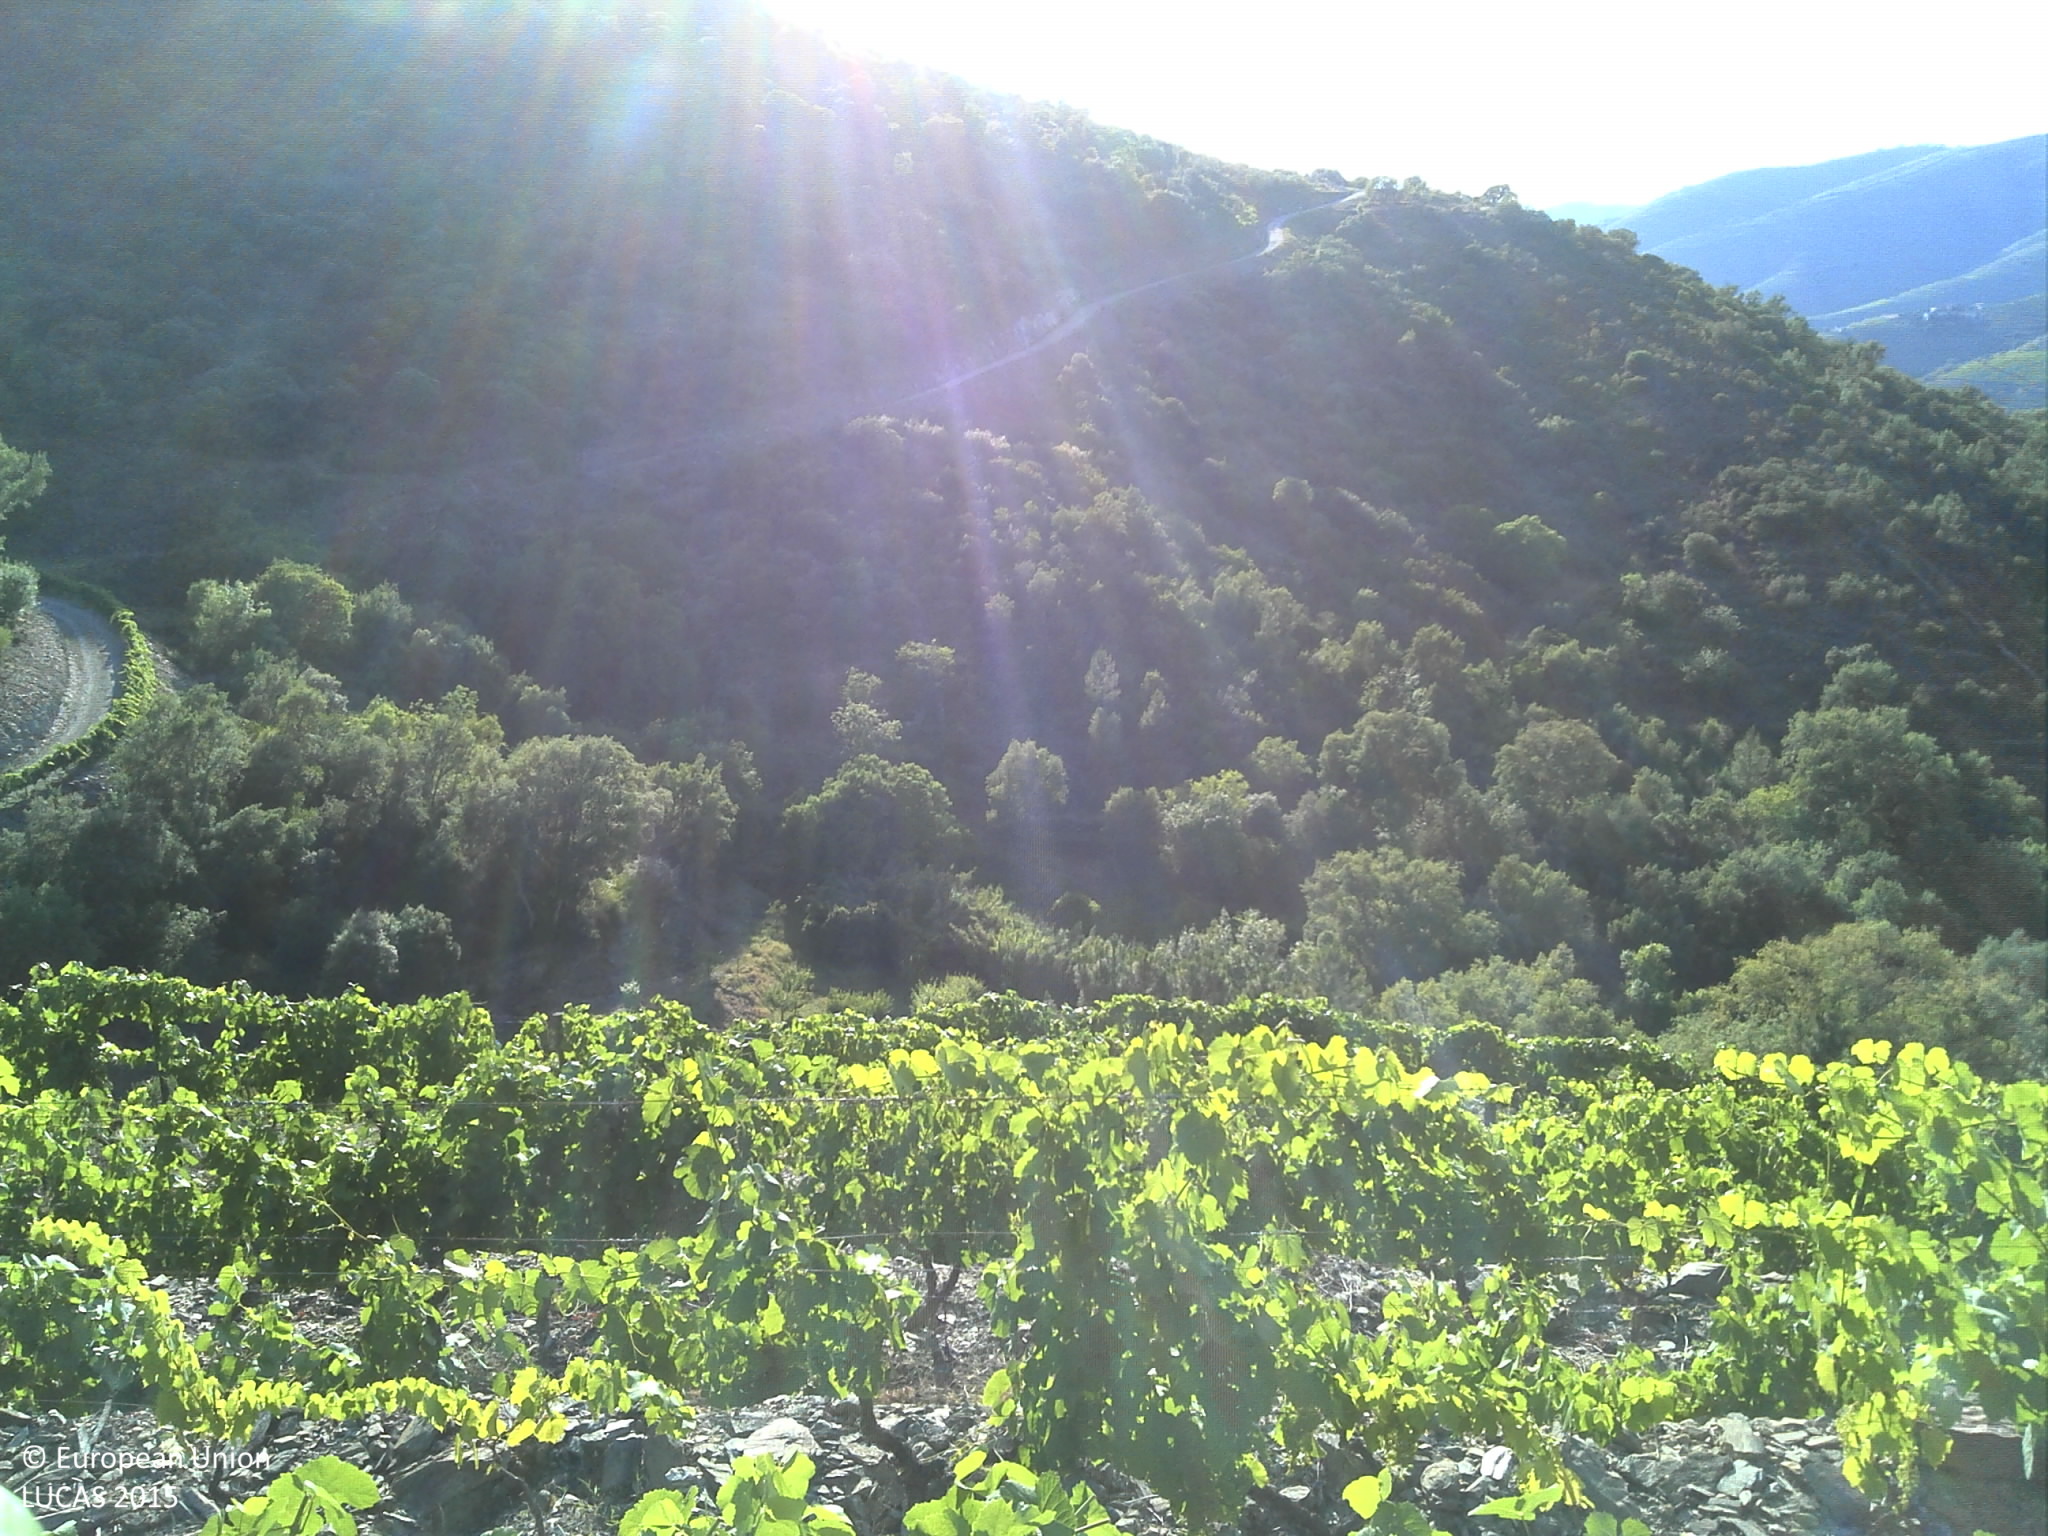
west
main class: Cropland
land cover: Vineyards
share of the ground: 10 - 25 %
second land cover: Grassland without tree/shrub cover
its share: 25 - 50 %
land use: Agriculture (excluding fallow land and kitchen gardens)
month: June
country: PT
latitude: 41.1529
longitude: -7.6053
